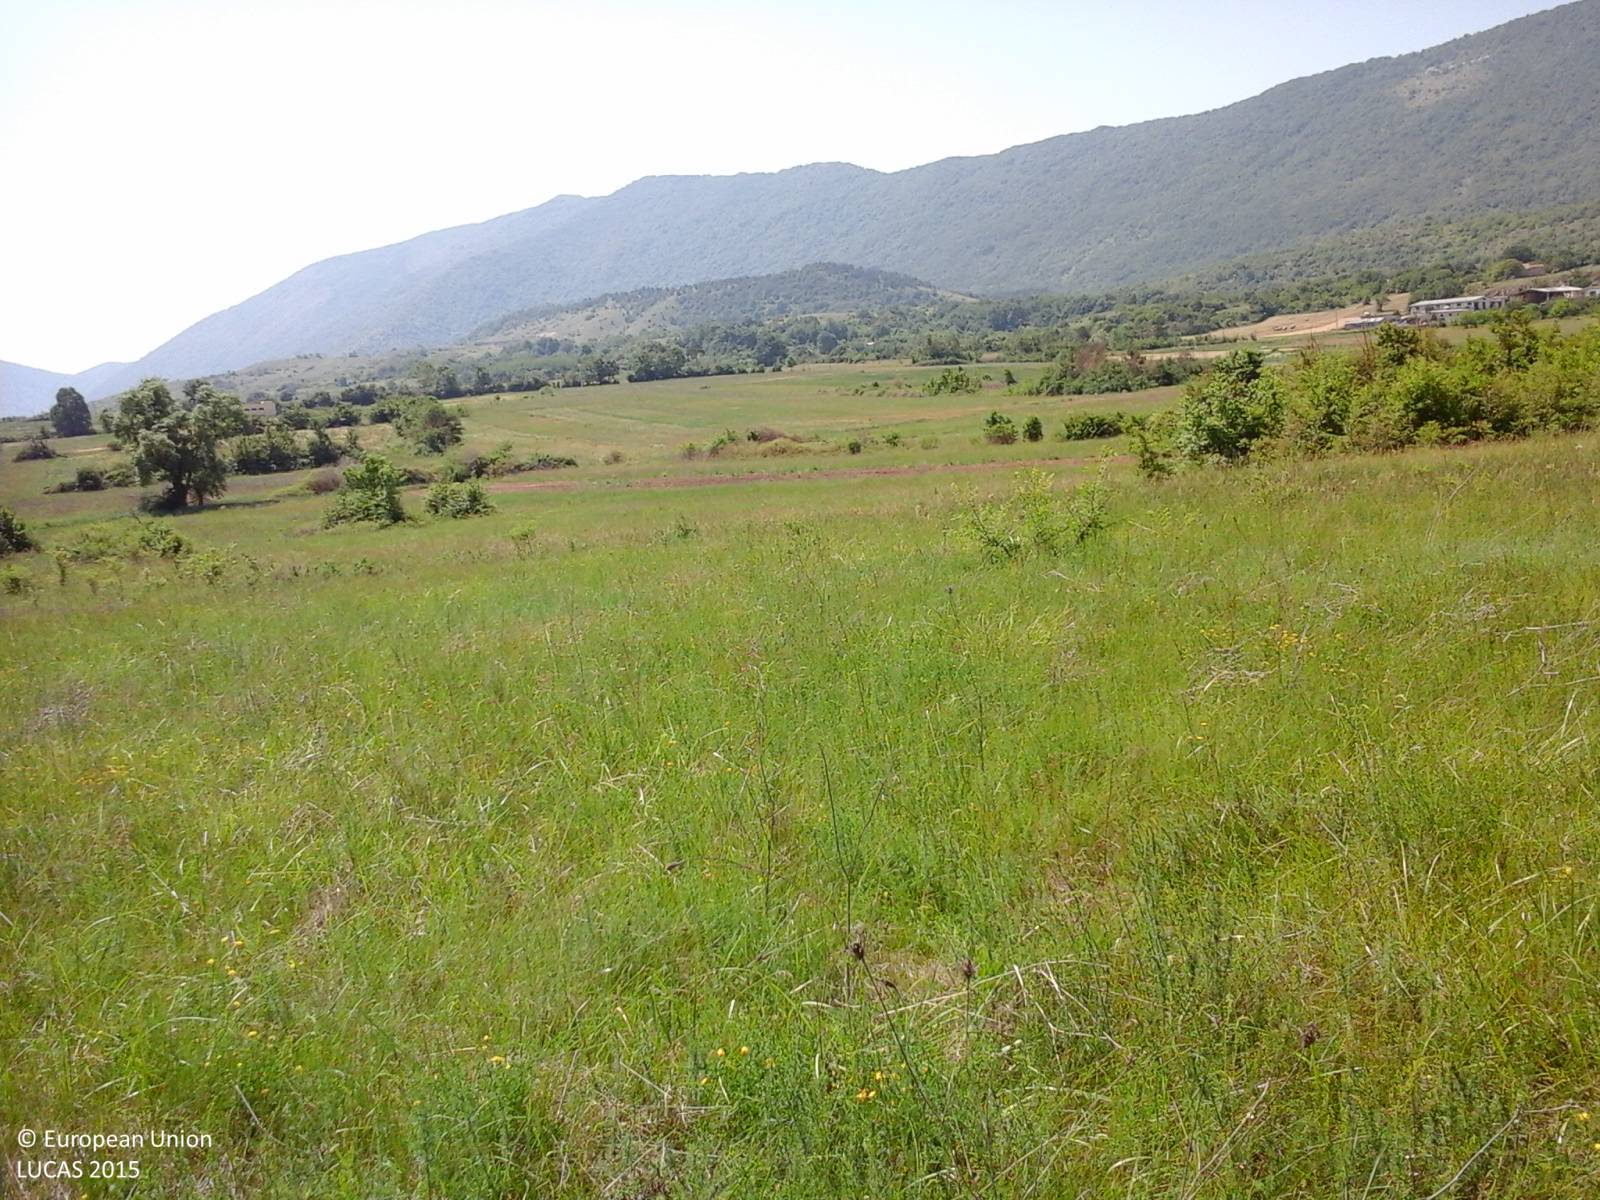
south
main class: Grassland
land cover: Grassland without tree/shrub cover
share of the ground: > 75 %
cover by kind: herbaceous plants 100 %
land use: Agriculture (excluding fallow land and kitchen gardens)
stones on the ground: < 10 %
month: June
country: IT
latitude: 42.0198
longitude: 13.3577
